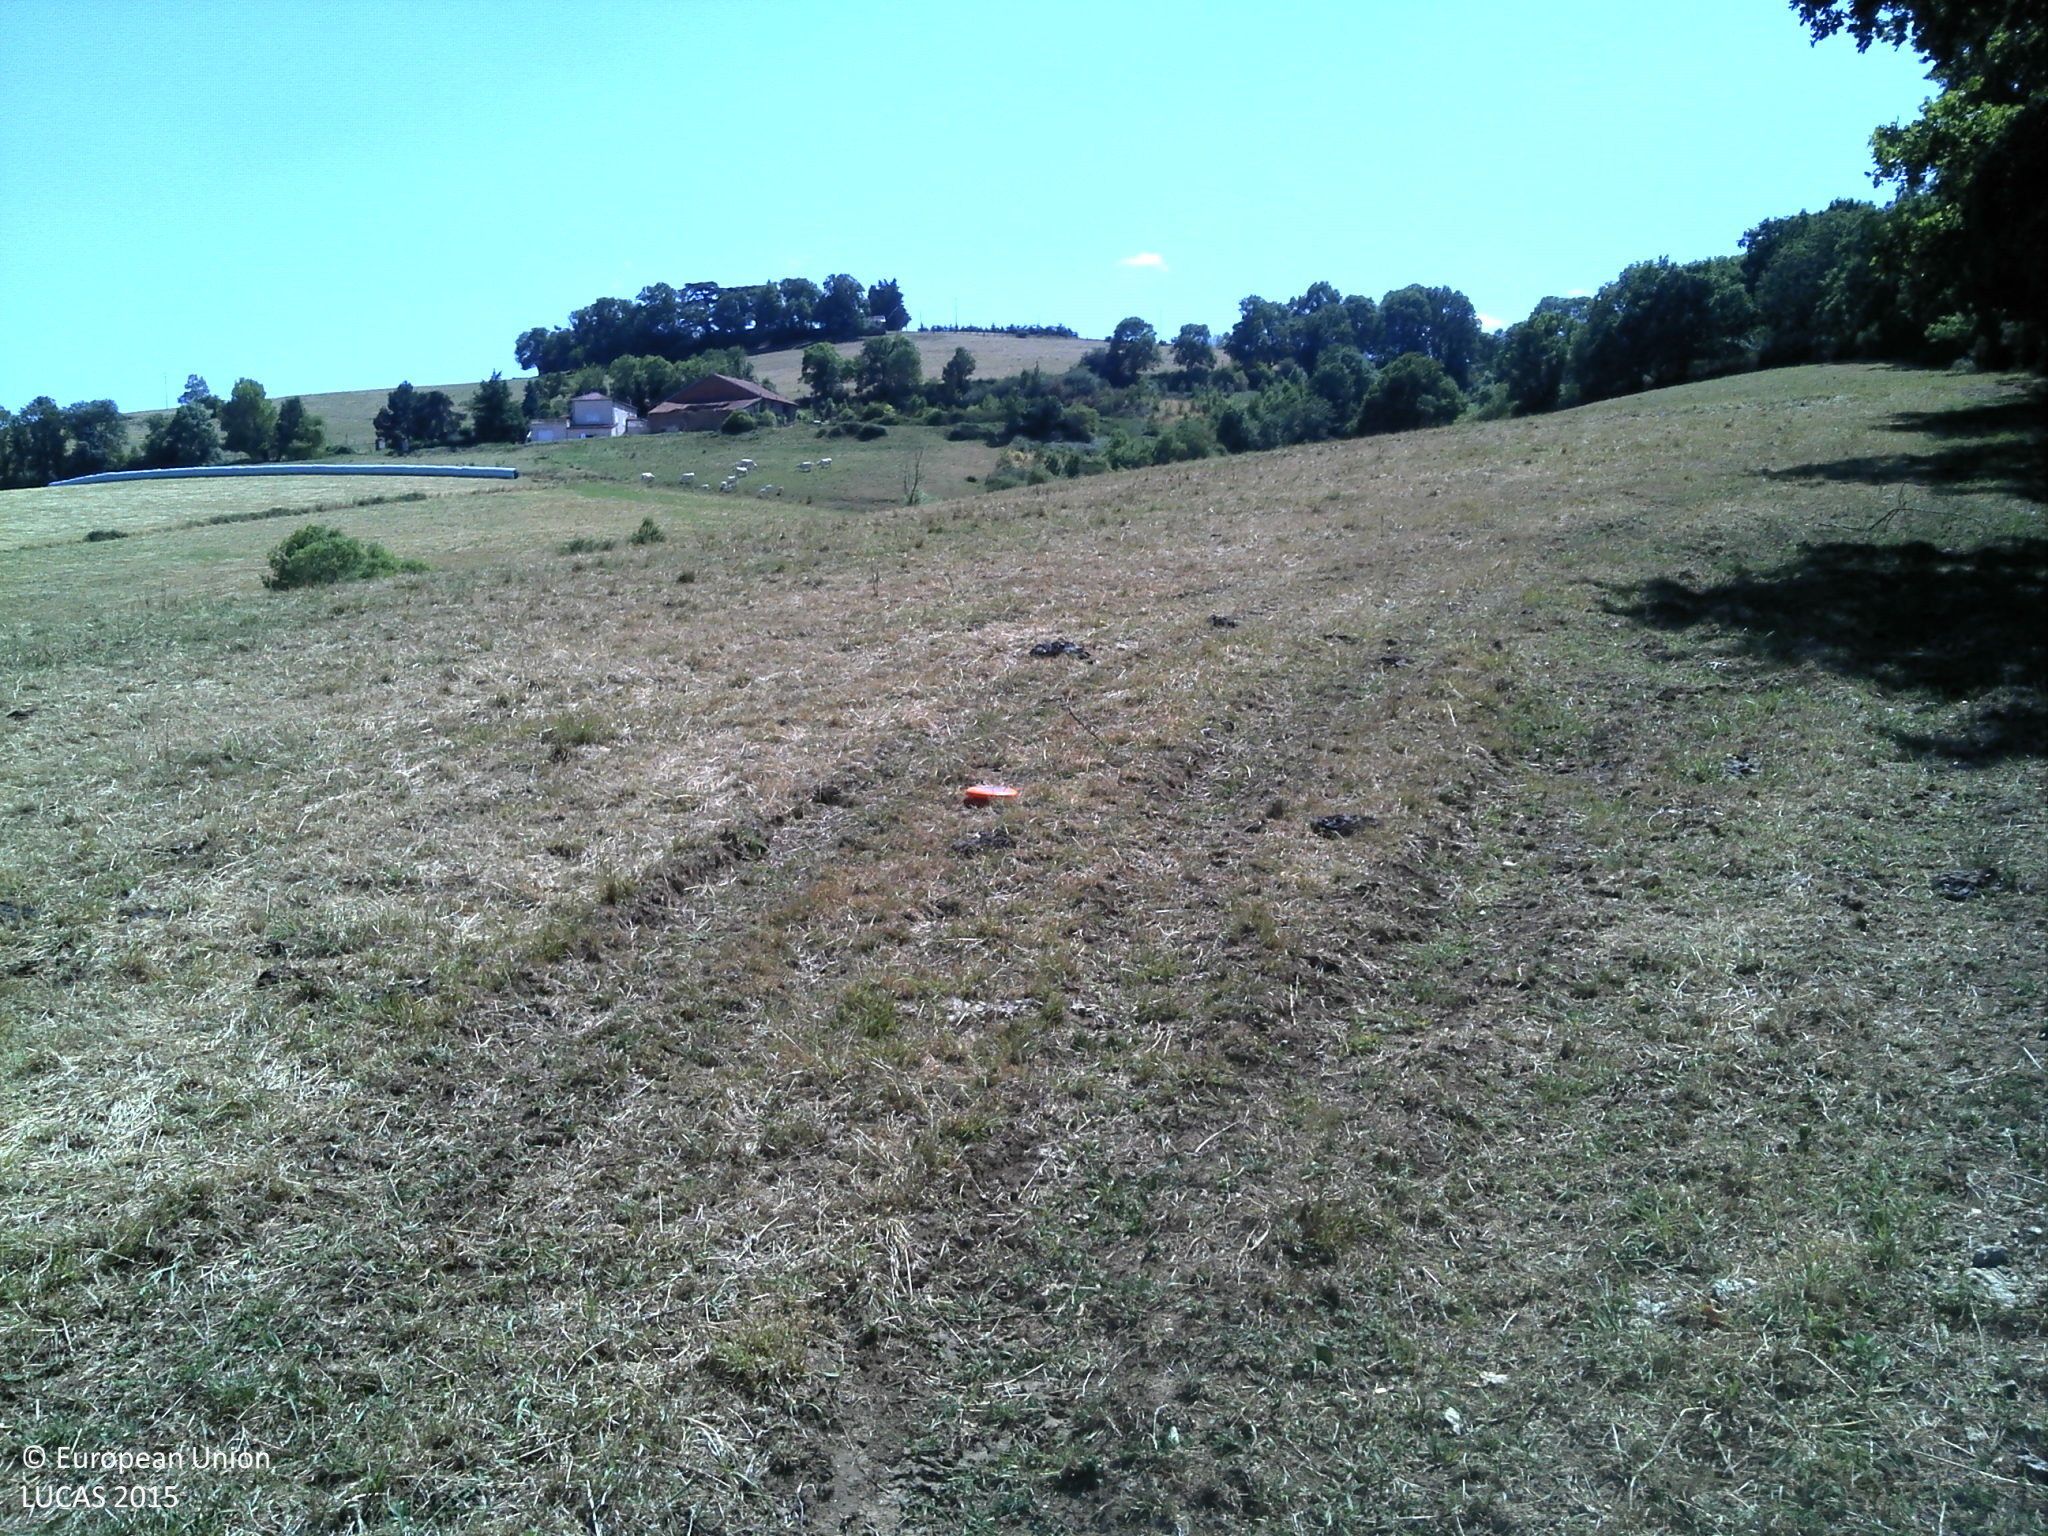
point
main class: Grassland
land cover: Grassland without tree/shrub cover
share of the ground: > 75 %
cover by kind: herbaceous plants 100 %
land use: Agriculture (excluding fallow land and kitchen gardens)
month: July
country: FR
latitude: 45.9539
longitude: 4.1058
